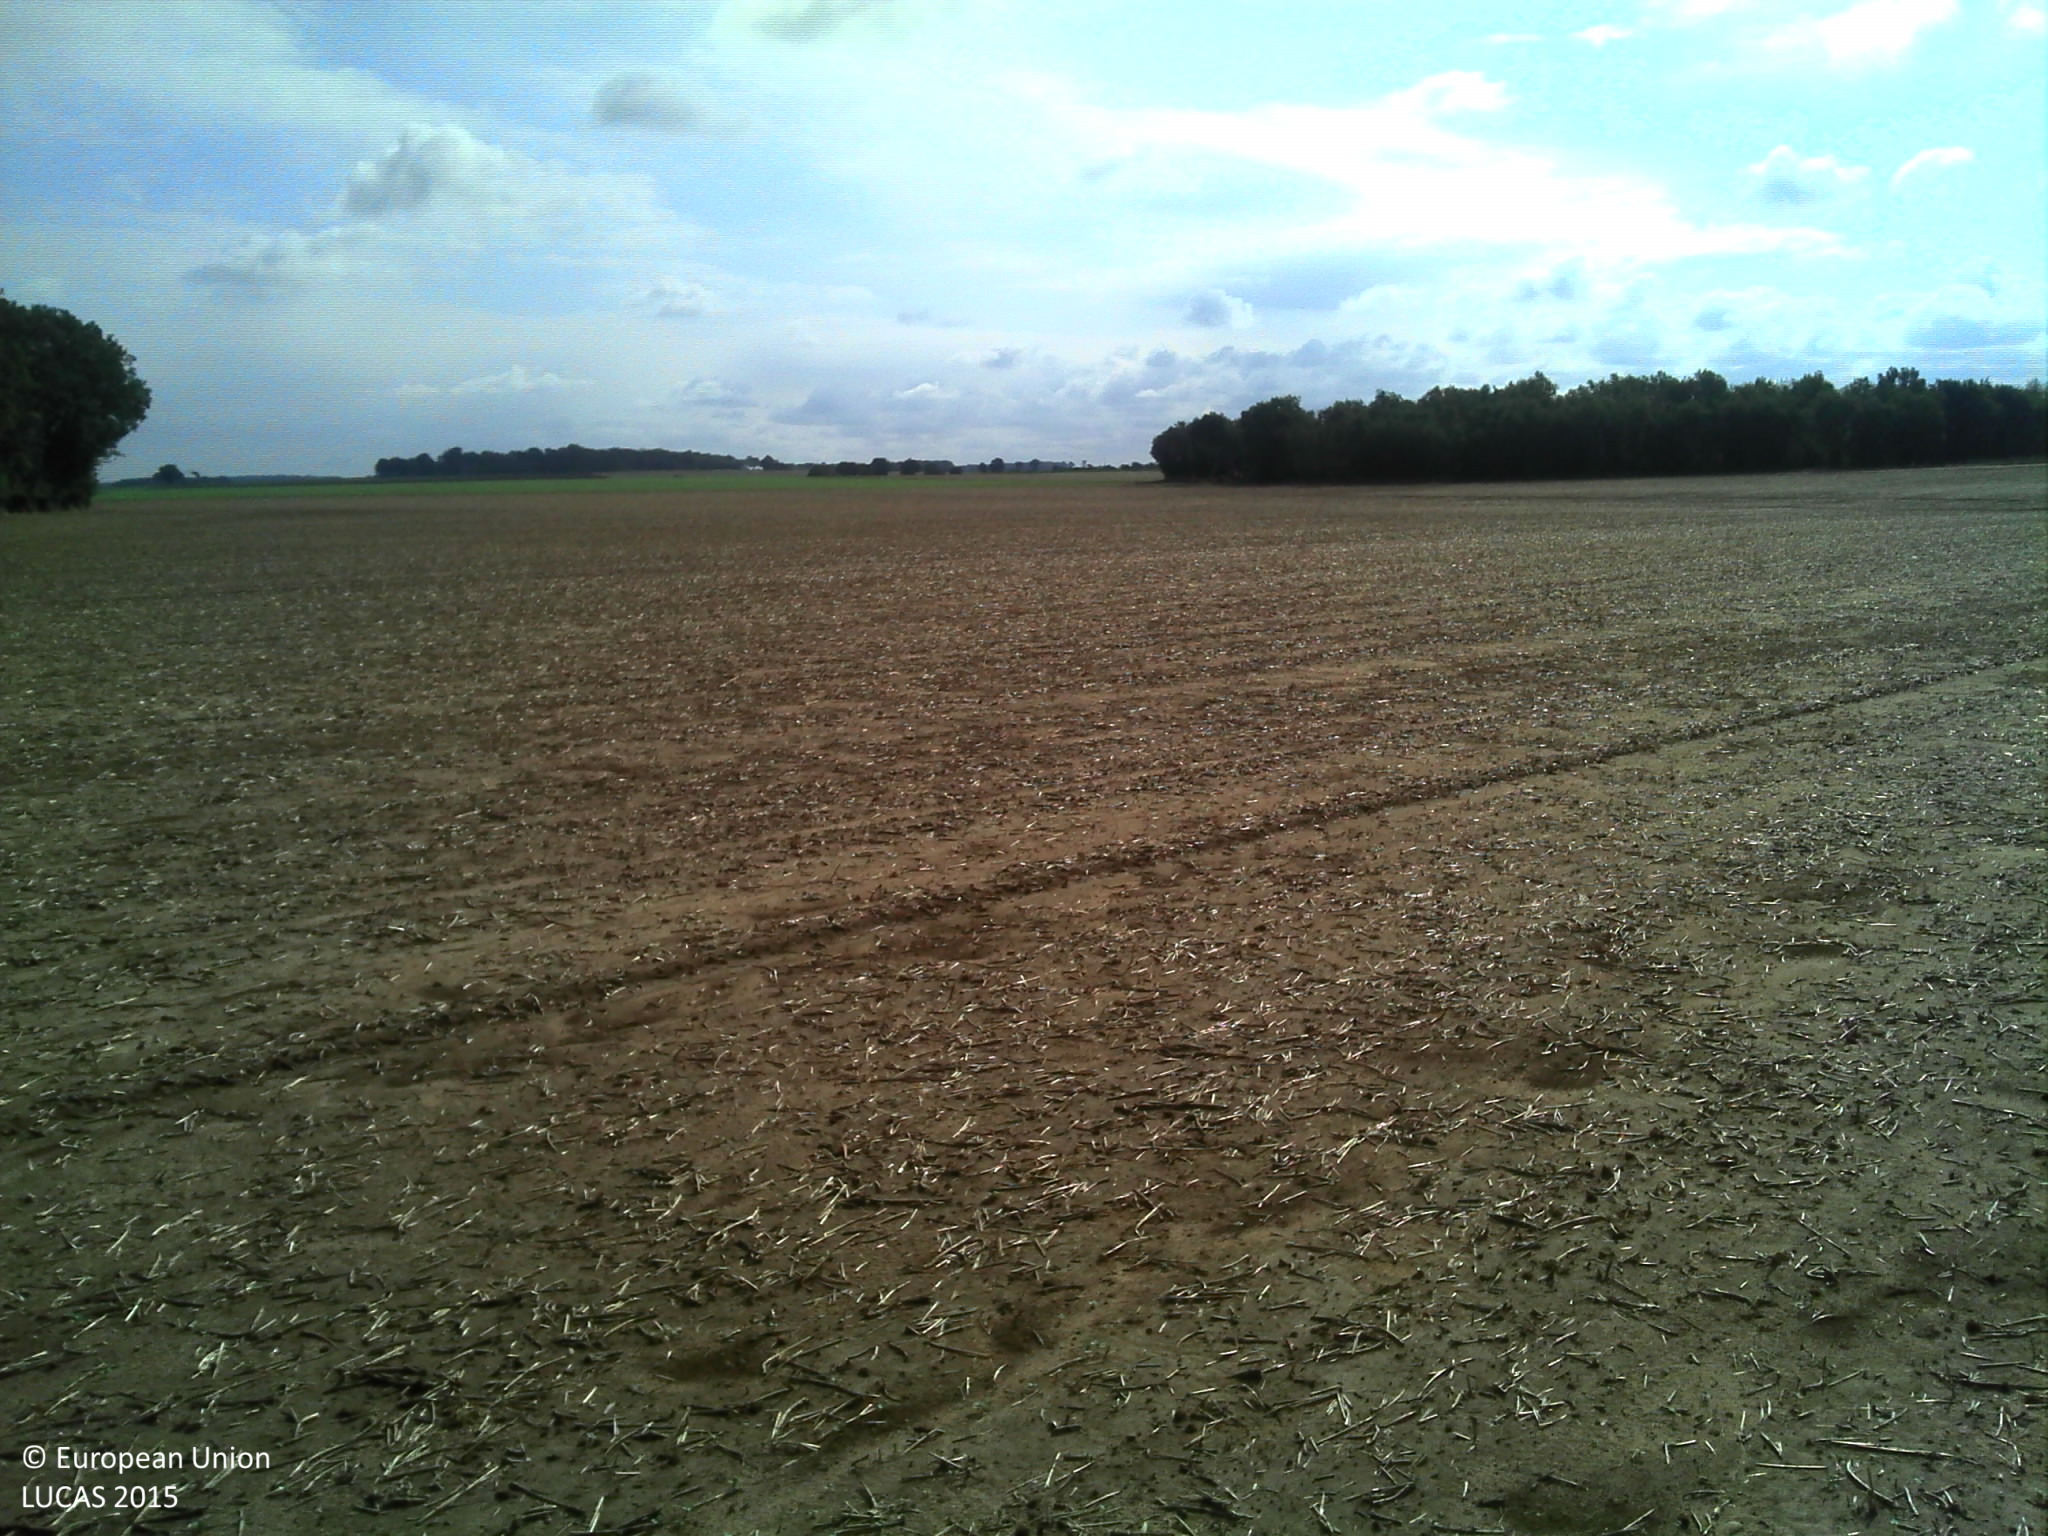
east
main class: Cropland
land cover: Other fibre and oleaginous crops
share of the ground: < 10 %
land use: Agriculture (excluding fallow land and kitchen gardens)
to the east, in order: Other fibre and oleaginous crops
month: September
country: FR
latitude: 46.9129
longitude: 1.4403
